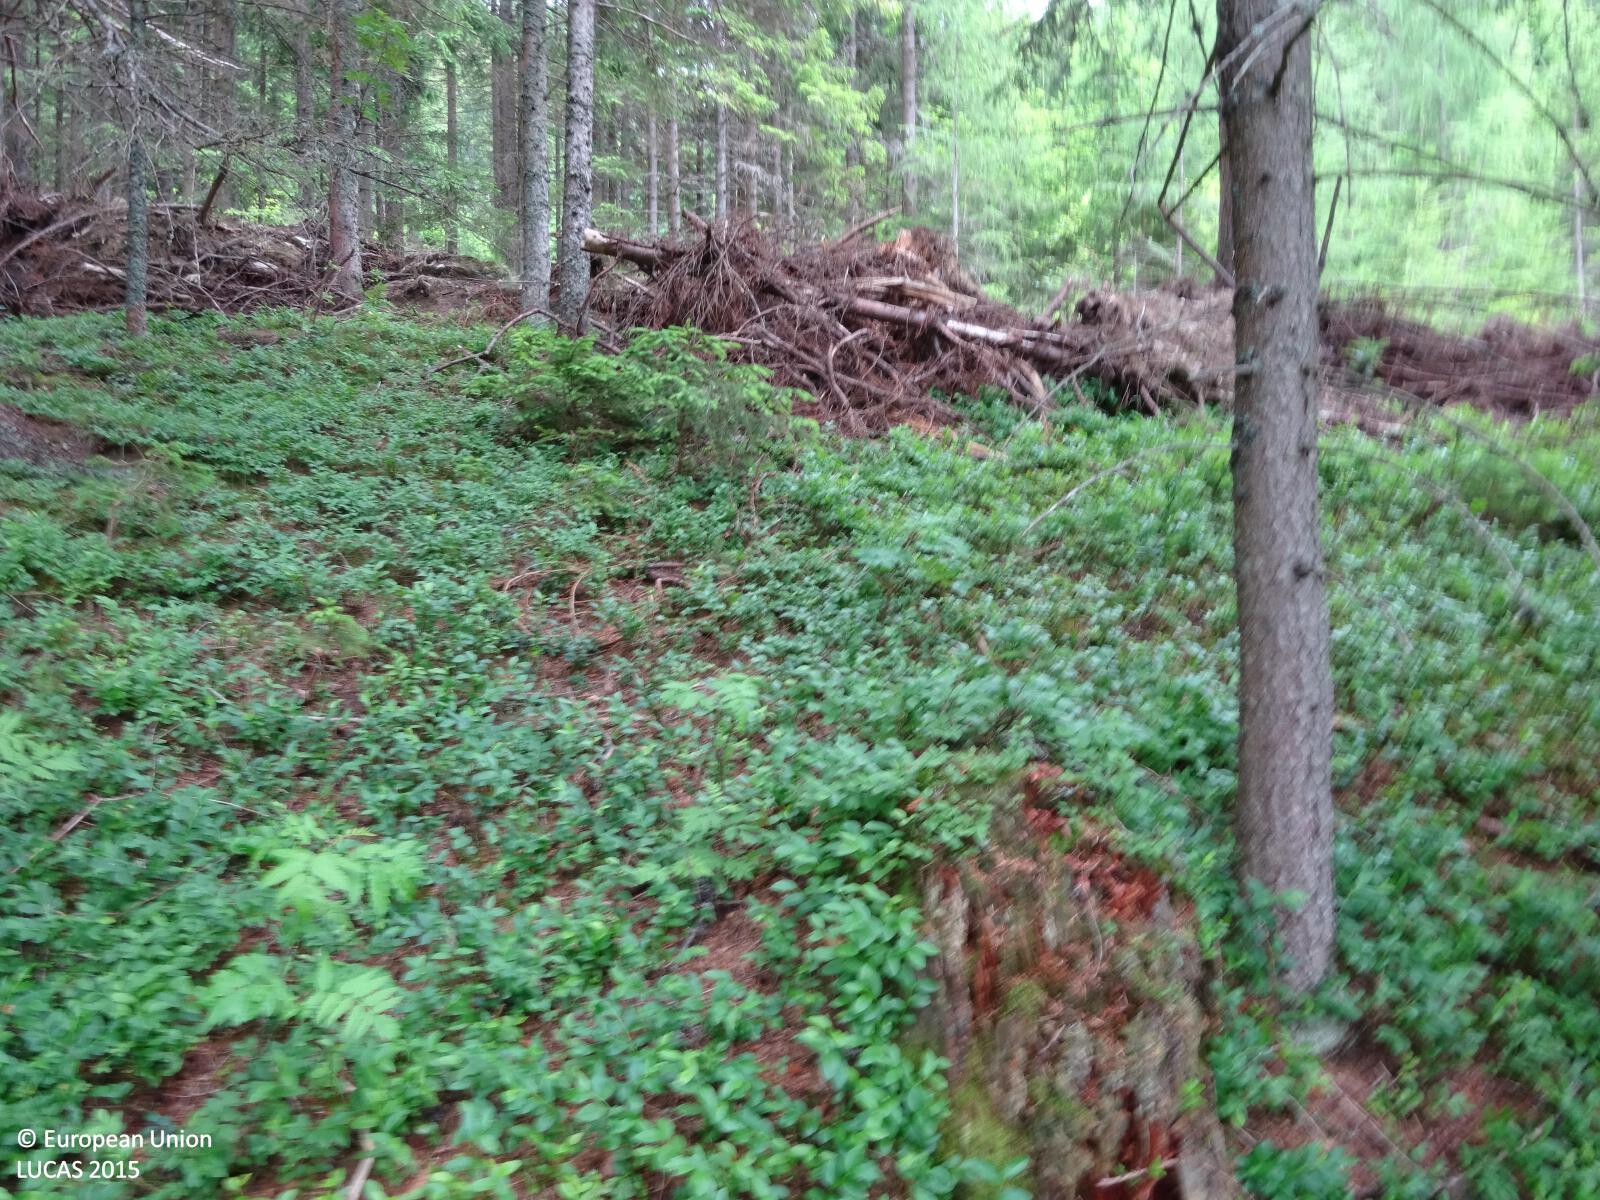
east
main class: Woodland
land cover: Spruce dominated coniferous woodland
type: alpine coniferous forest
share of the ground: > 75 %
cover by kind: coniferous forest trees 85 %, shrubs 10 %, herbaceous plants 5 %
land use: Forestry
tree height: > 5 m
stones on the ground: < 10 %
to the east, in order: Spruce dominated coniferous woodland; Tracks; Spruce dominated coniferous woodland; Tracks; Spruce dominated coniferous woodland; Tracks; Spruce dominated coniferous woodland
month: June
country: AT
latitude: 47.5859
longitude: 15.7593
